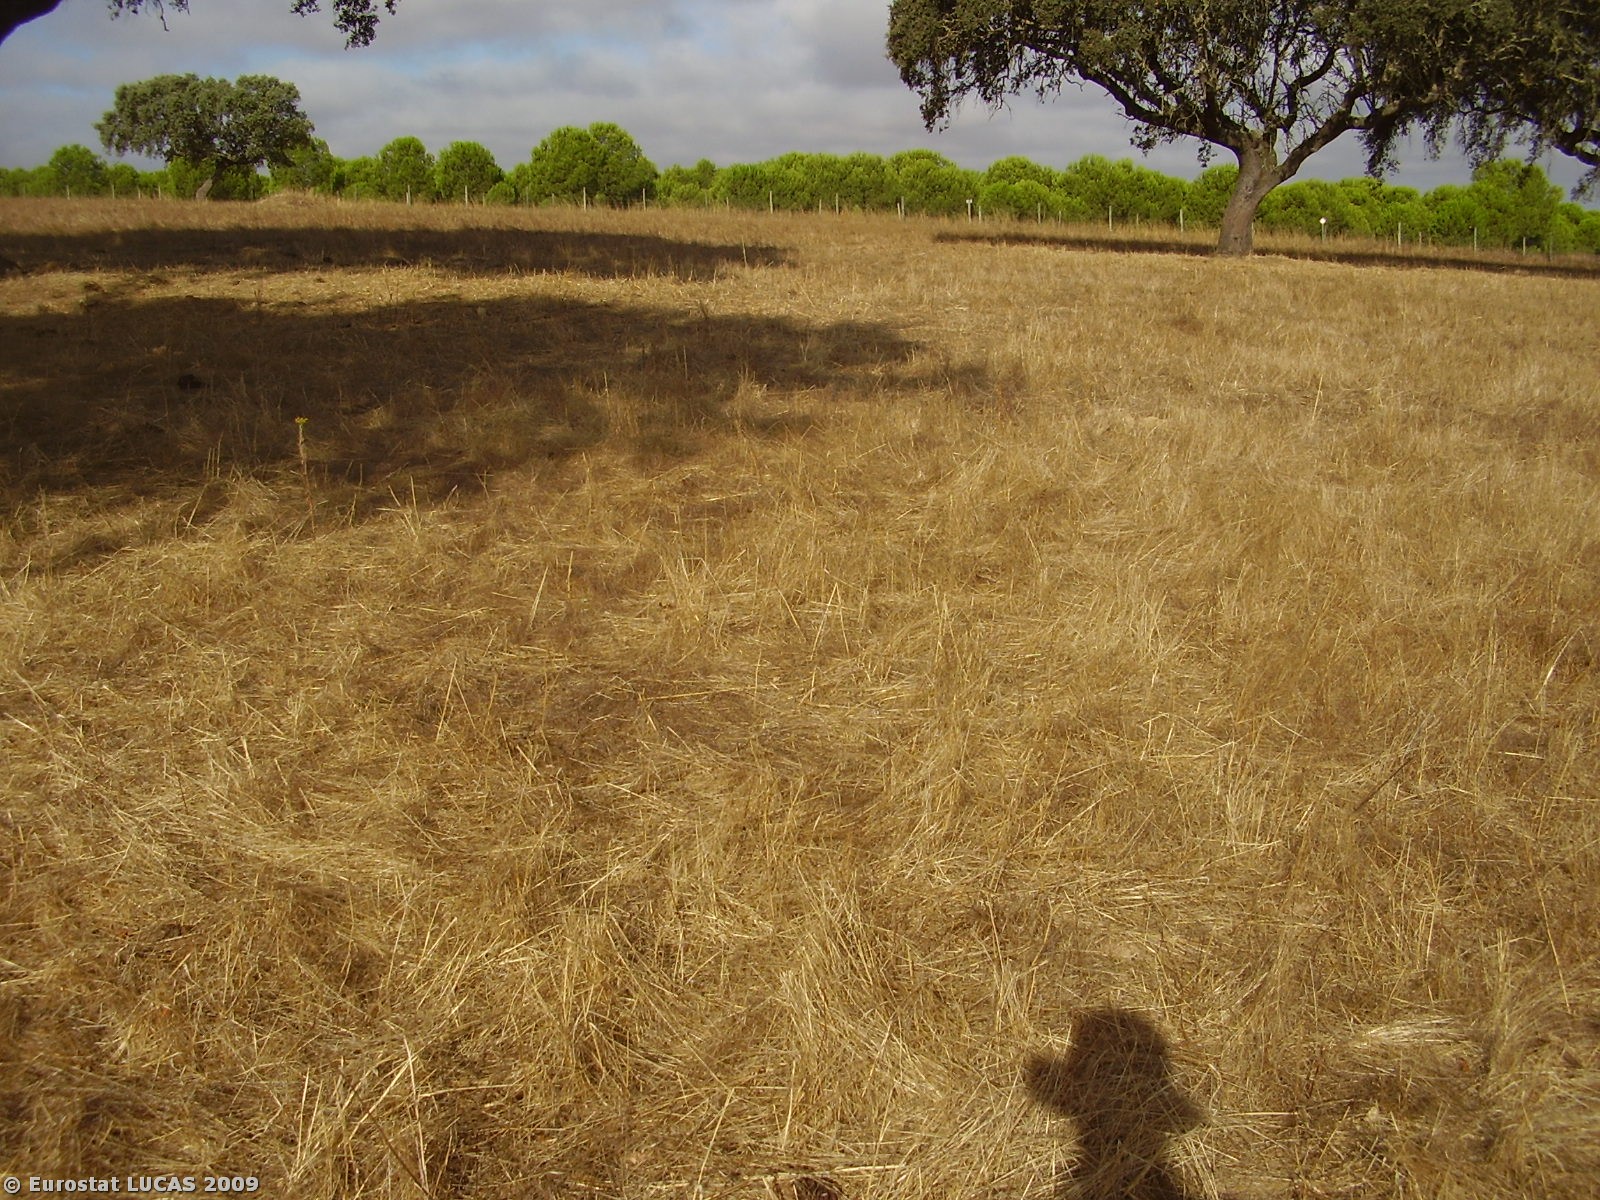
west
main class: Grassland
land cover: Grassland with sparse tree/shrub cover
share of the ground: > 75 %
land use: Fallow land
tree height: > 5 m
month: August
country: PT
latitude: 38.1114
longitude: -7.9726
